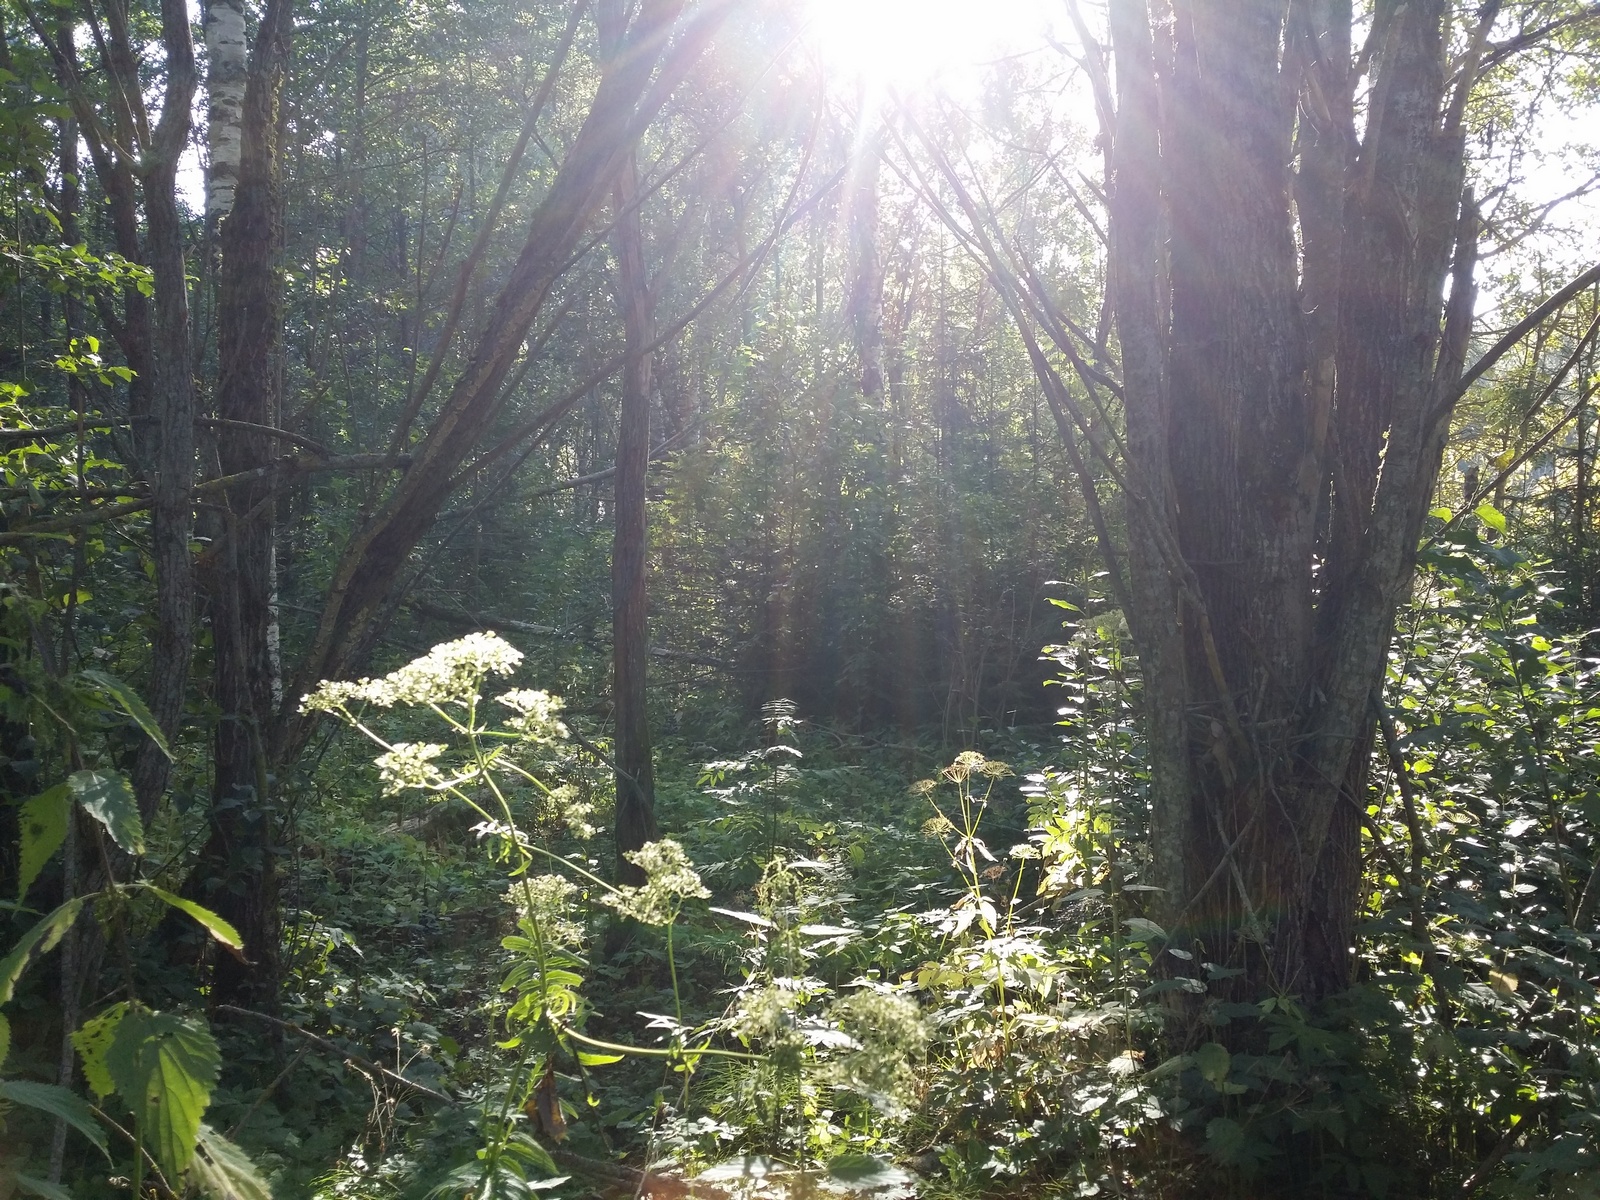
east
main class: Woodland
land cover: Broadleaved woodland
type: non-riverine alder, birch or aspen forest
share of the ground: > 75 %
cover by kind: broadleaved forest trees 75 %, shrubs 20 %, coniferous forest trees 5 %
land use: Forestry
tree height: > 5 m
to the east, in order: Broadleaved woodland; Ditches and canals; Broadleaved woodland
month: August
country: LV
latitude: 56.9084
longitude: 27.6388
